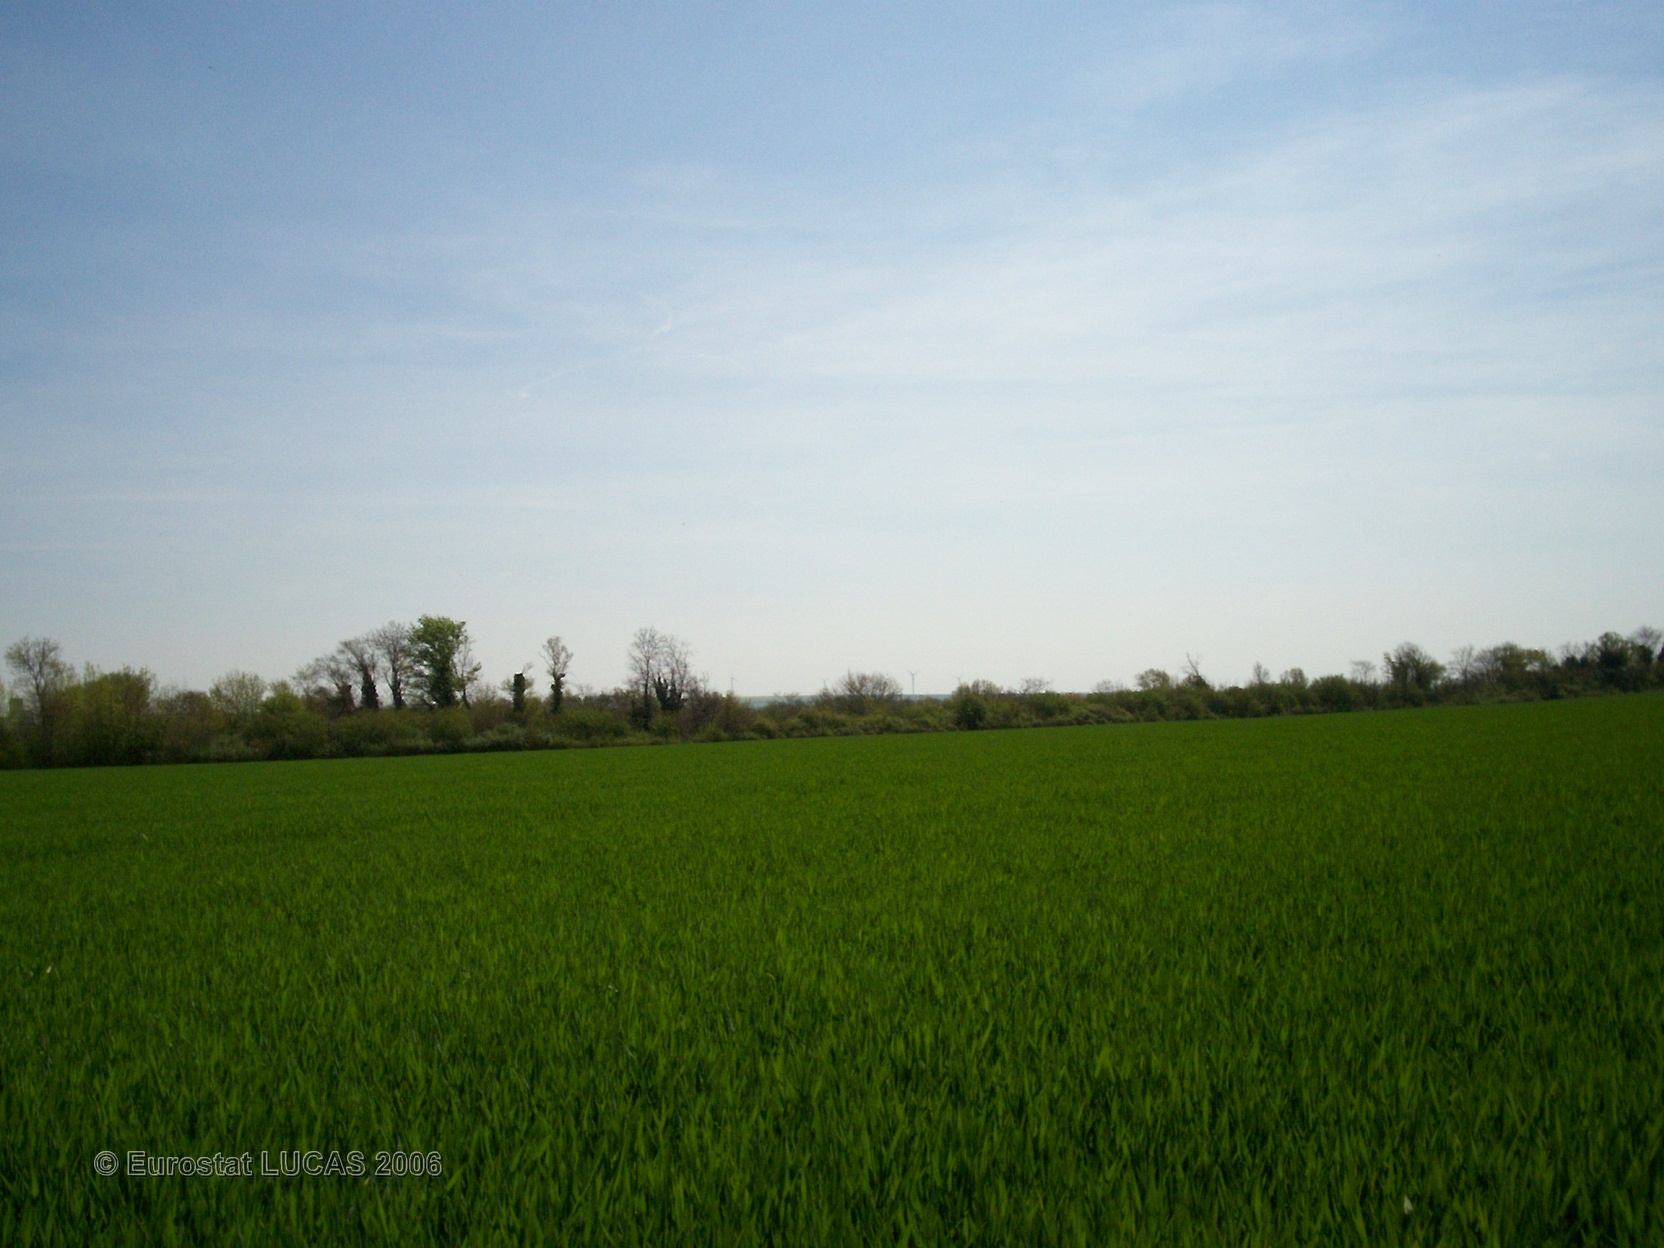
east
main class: Cropland
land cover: Barley
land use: Agriculture (excluding fallow land and kitchen gardens)
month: May
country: FR
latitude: 48.8758
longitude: 4.4199
